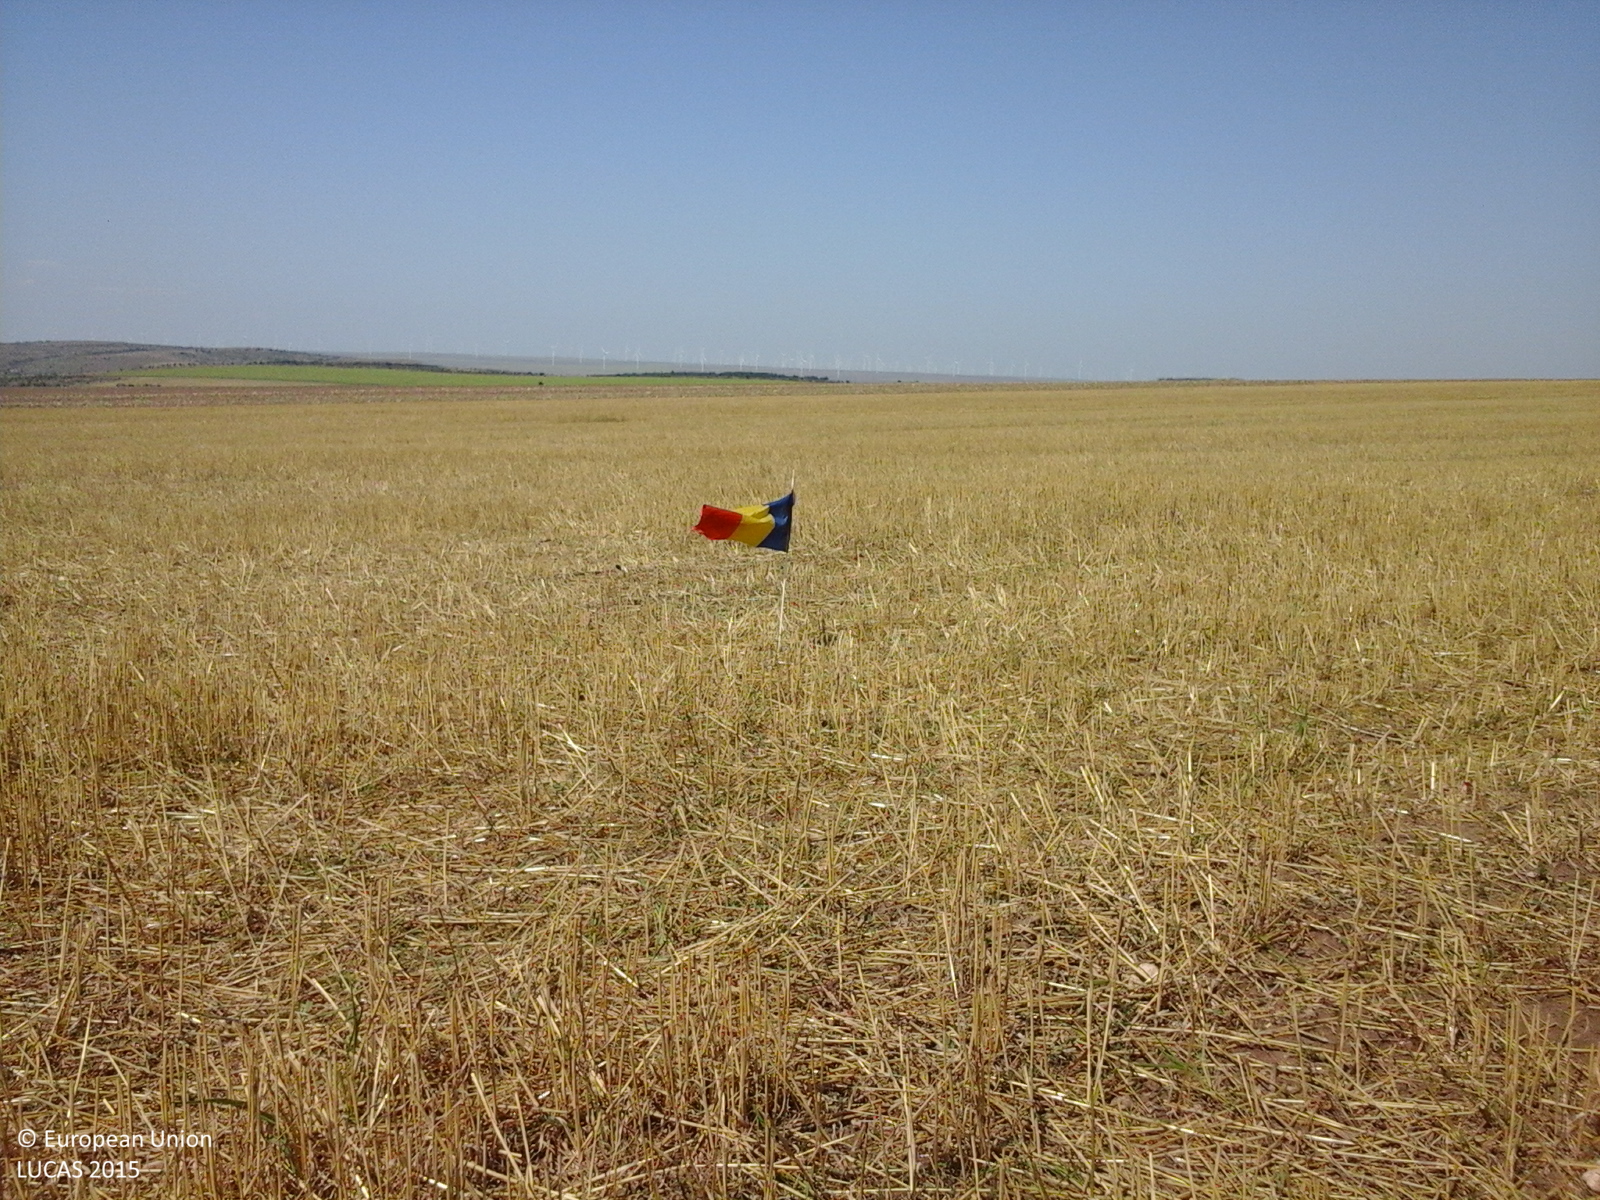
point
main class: Cropland
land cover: Common wheat
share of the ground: 10 - 25 %
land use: Agriculture (excluding fallow land and kitchen gardens)
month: August
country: RO
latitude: 44.4456
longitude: 28.4801
